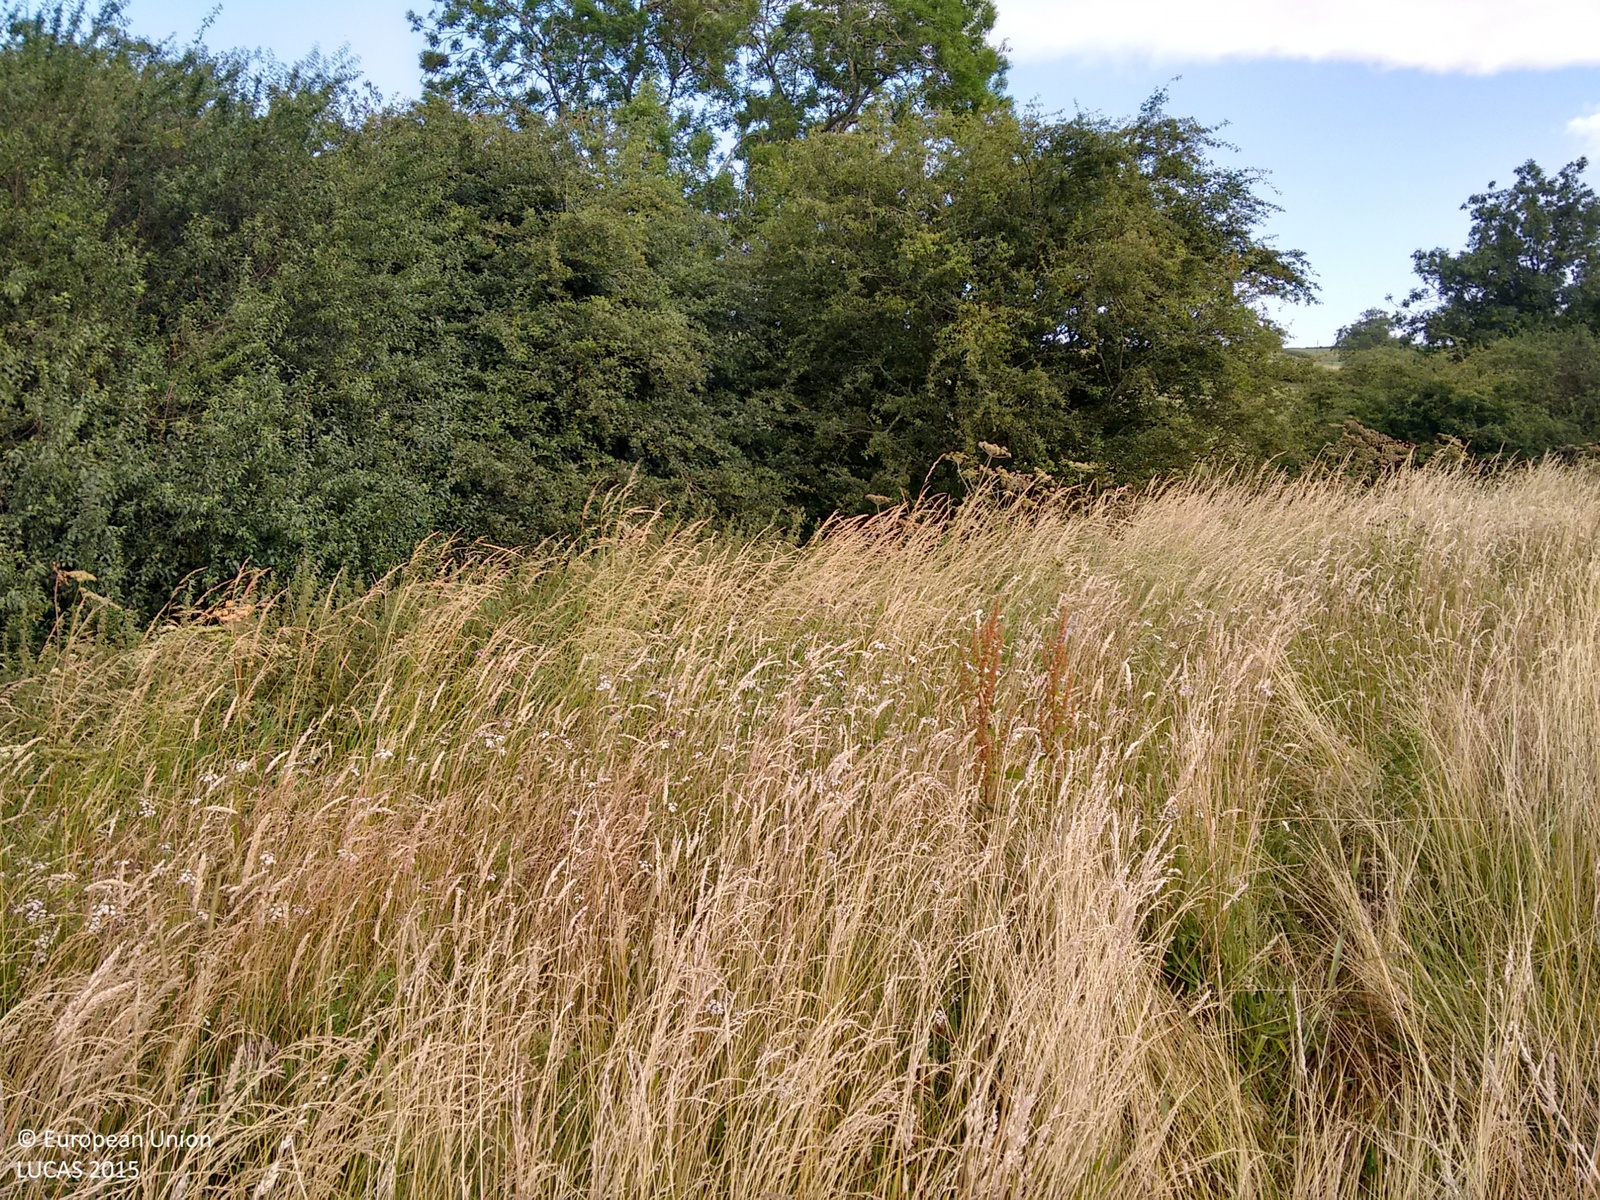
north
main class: Grassland
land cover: Grassland with sparse tree/shrub cover
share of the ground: > 75 %
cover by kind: herbaceous plants 95 %, broadleaved forest trees 5 %
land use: Agriculture (excluding fallow land and kitchen gardens)
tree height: < 5 m
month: July
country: GB
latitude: 52.6766
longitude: -0.8539
